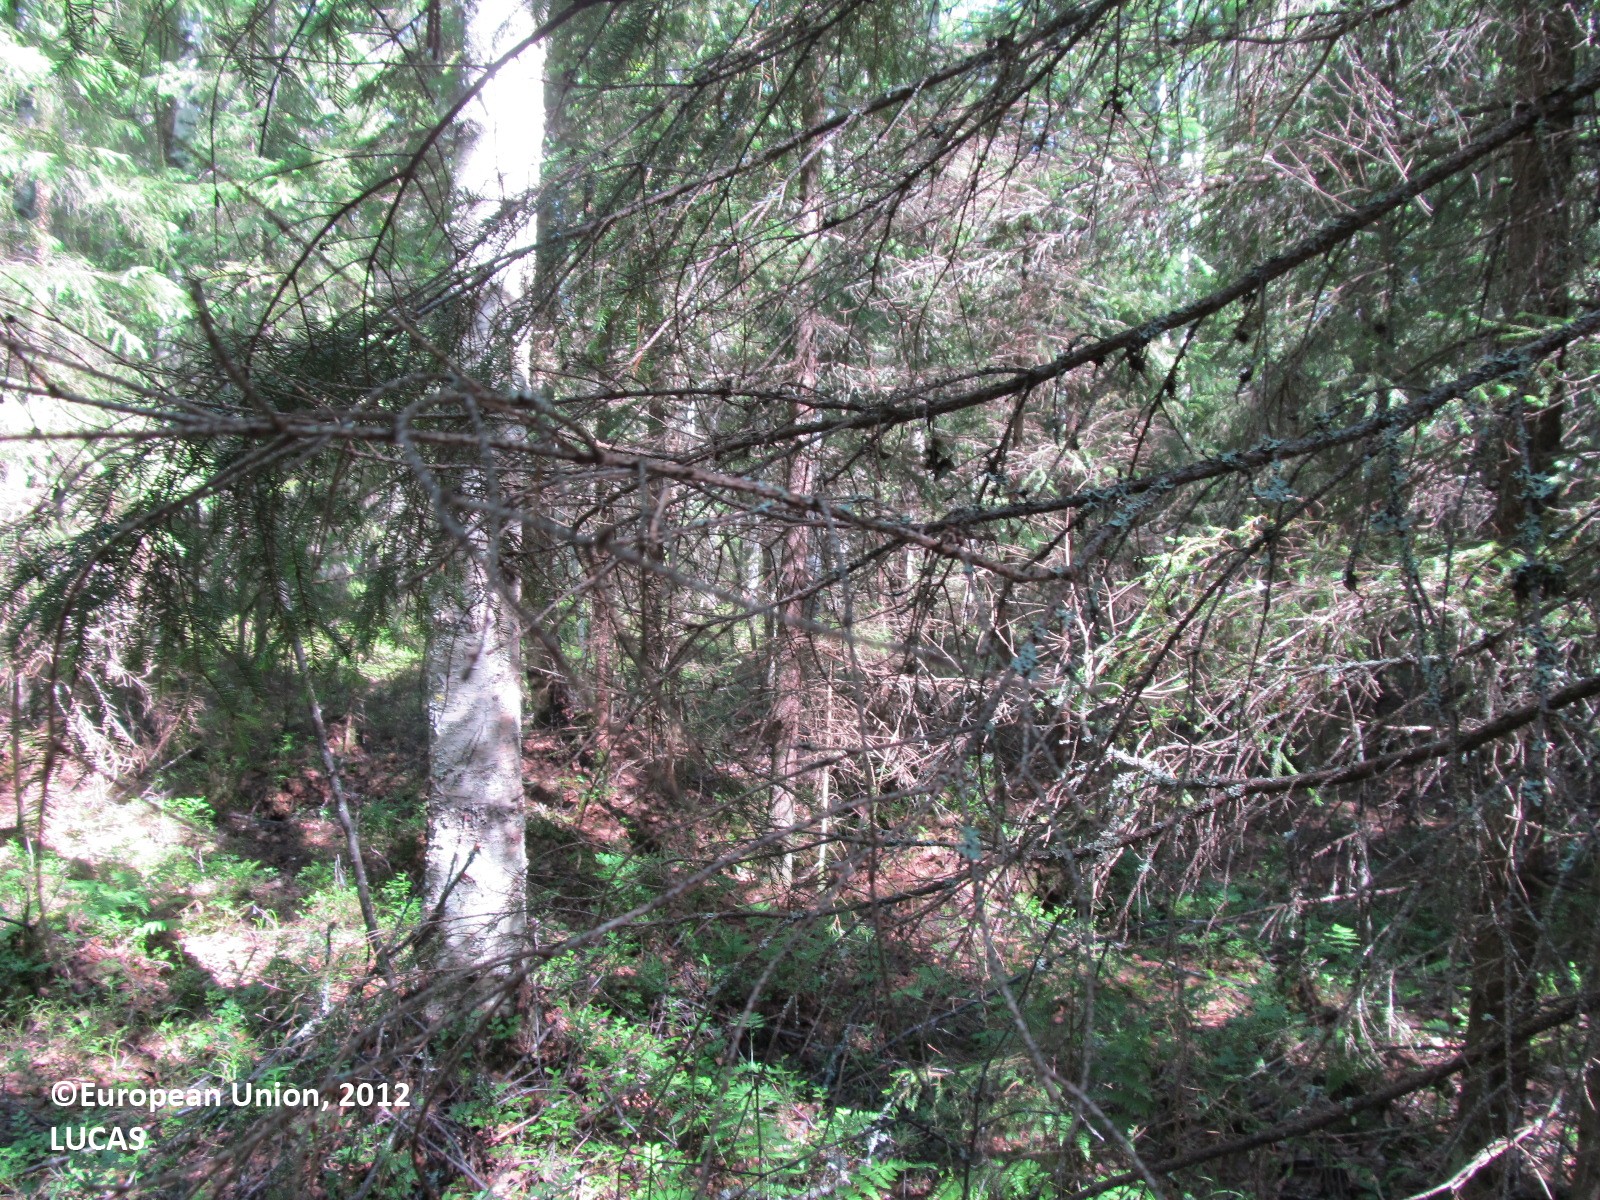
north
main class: Woodland
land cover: Spruce dominated mixed woodland
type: boreal forest
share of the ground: 50 - 75 %
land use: Forestry
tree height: > 5 m
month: July
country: FI
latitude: 62.4672
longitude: 29.1317
